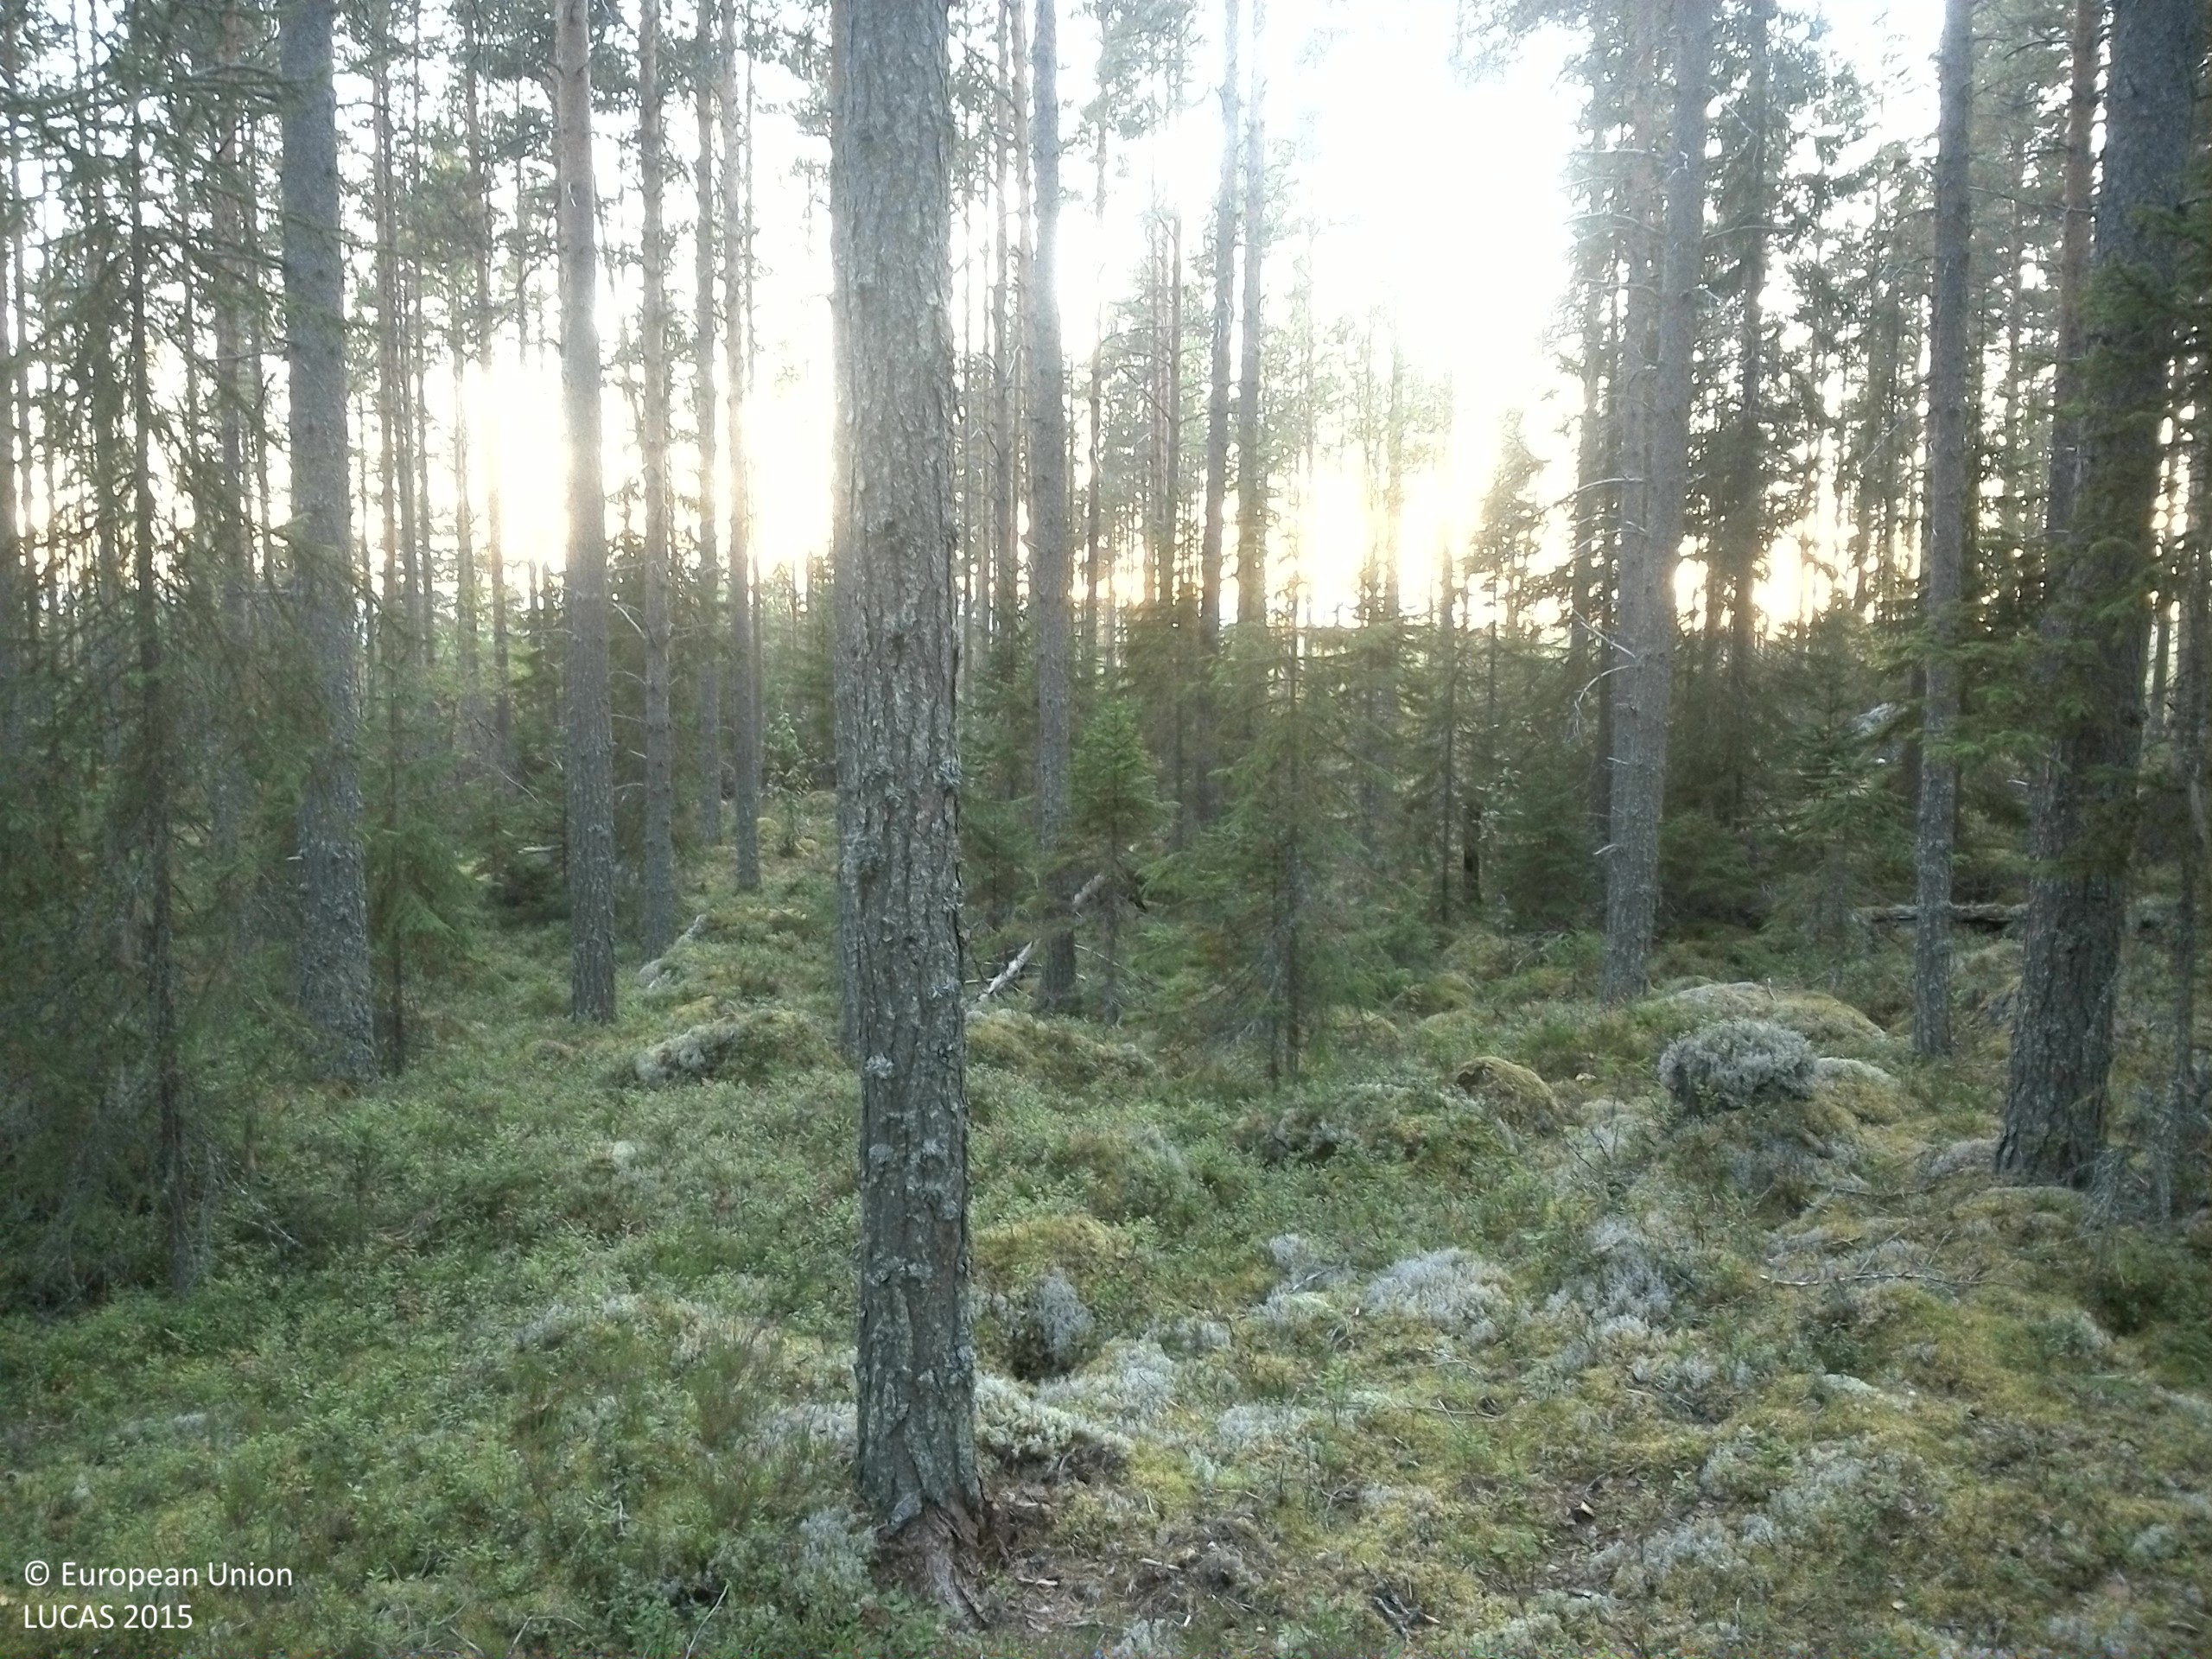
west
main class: Woodland
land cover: Pine dominated coniferous woodland
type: boreal forest
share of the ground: > 75 %
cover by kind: coniferous forest trees 75 %, shrubs 10 %, lichens and mosses 10 %, broadleaved forest trees 5 %
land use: Forestry
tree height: > 5 m
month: September
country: SE
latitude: 61.6288
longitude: 15.4354
